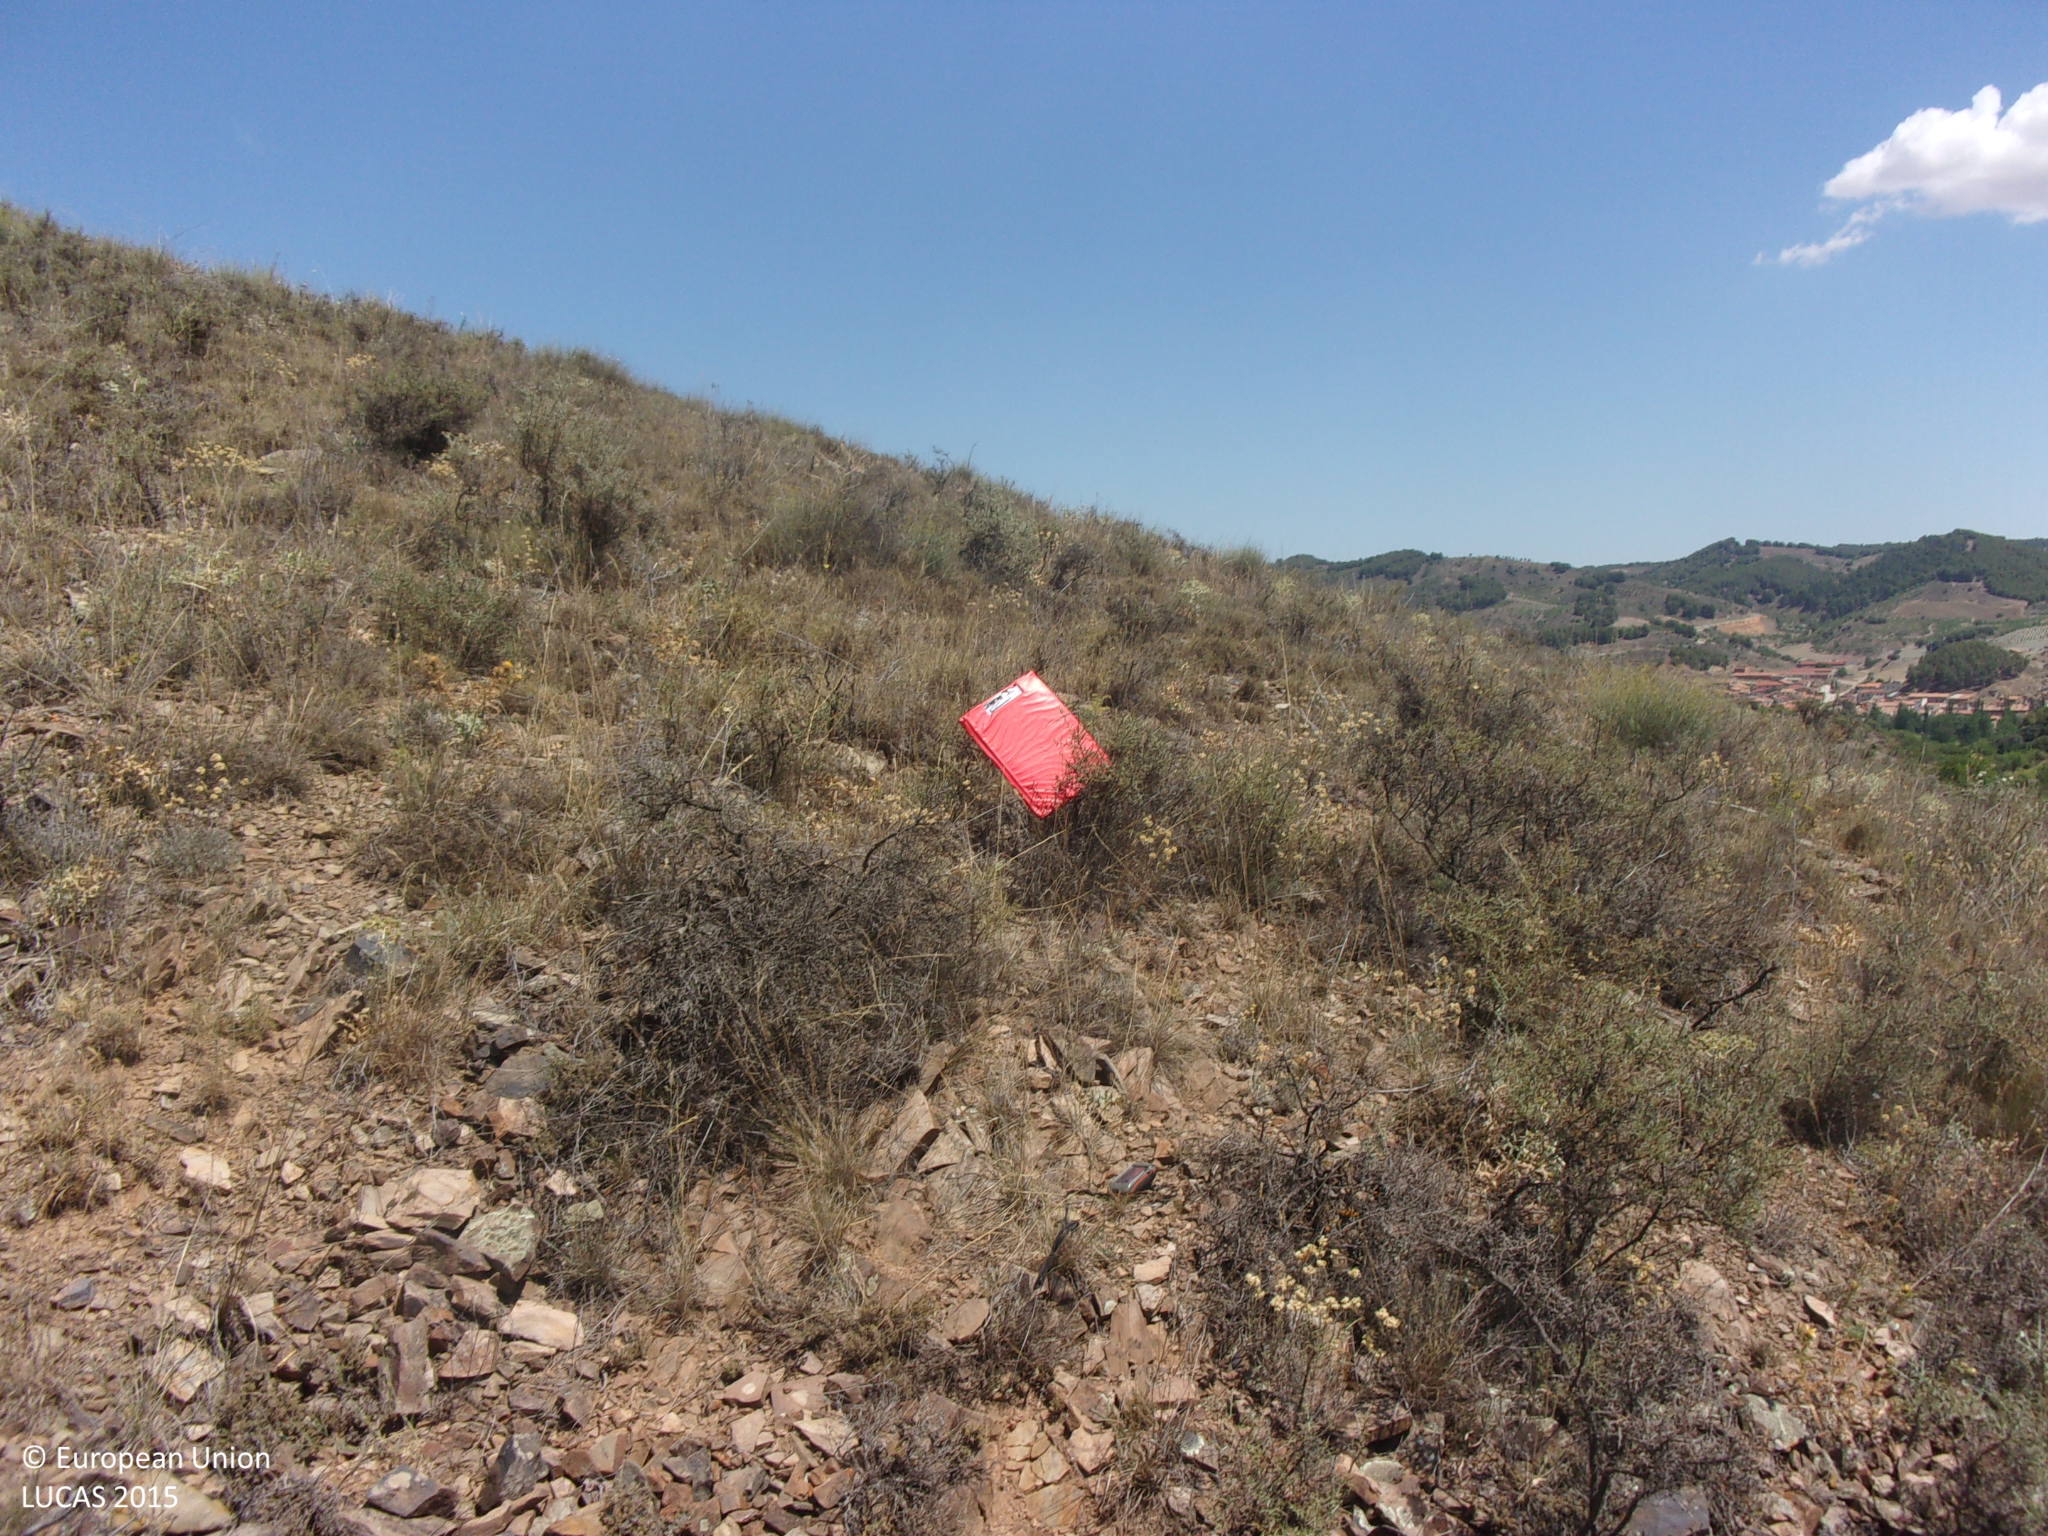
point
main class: Shrubland
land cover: Shrubland without tree cover
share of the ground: > 75 %
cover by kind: shrubs 80 %, herbaceous plants 10 %, consolidated bare surface 10 %
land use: Semi-natural and natural areas not in use
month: July
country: ES
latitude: 41.0112
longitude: -1.3510
